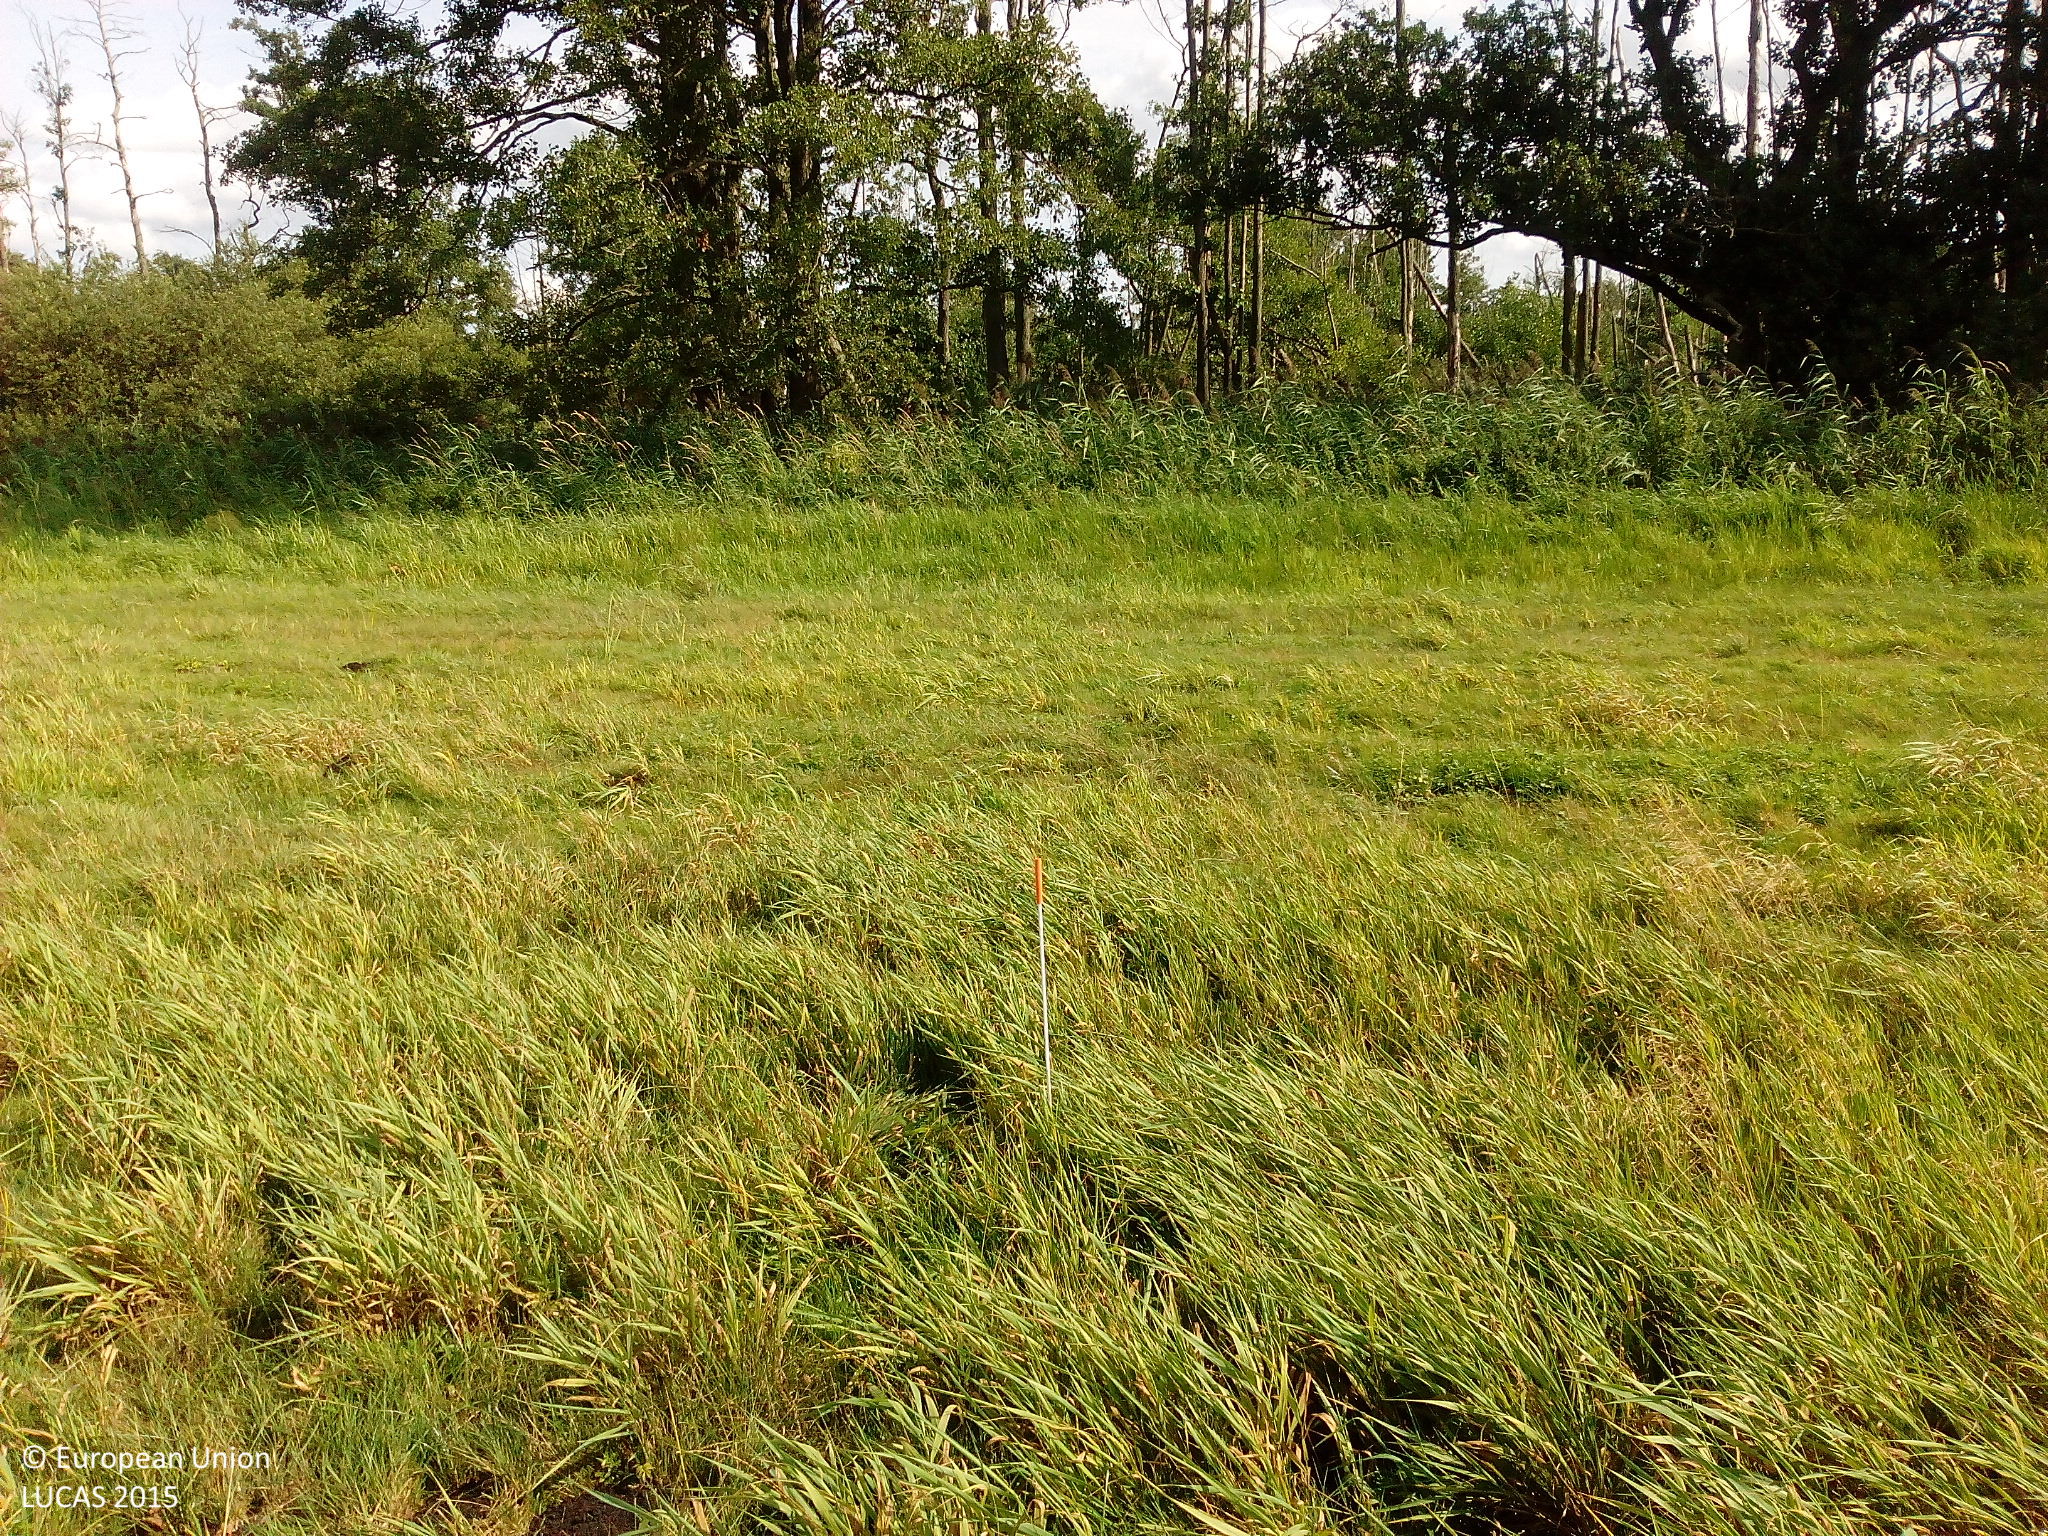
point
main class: Grassland
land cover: Grassland without tree/shrub cover
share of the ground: > 75 %
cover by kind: herbaceous plants 100 %
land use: Agriculture (excluding fallow land and kitchen gardens)
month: August
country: DE
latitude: 53.9295
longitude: 12.6949
